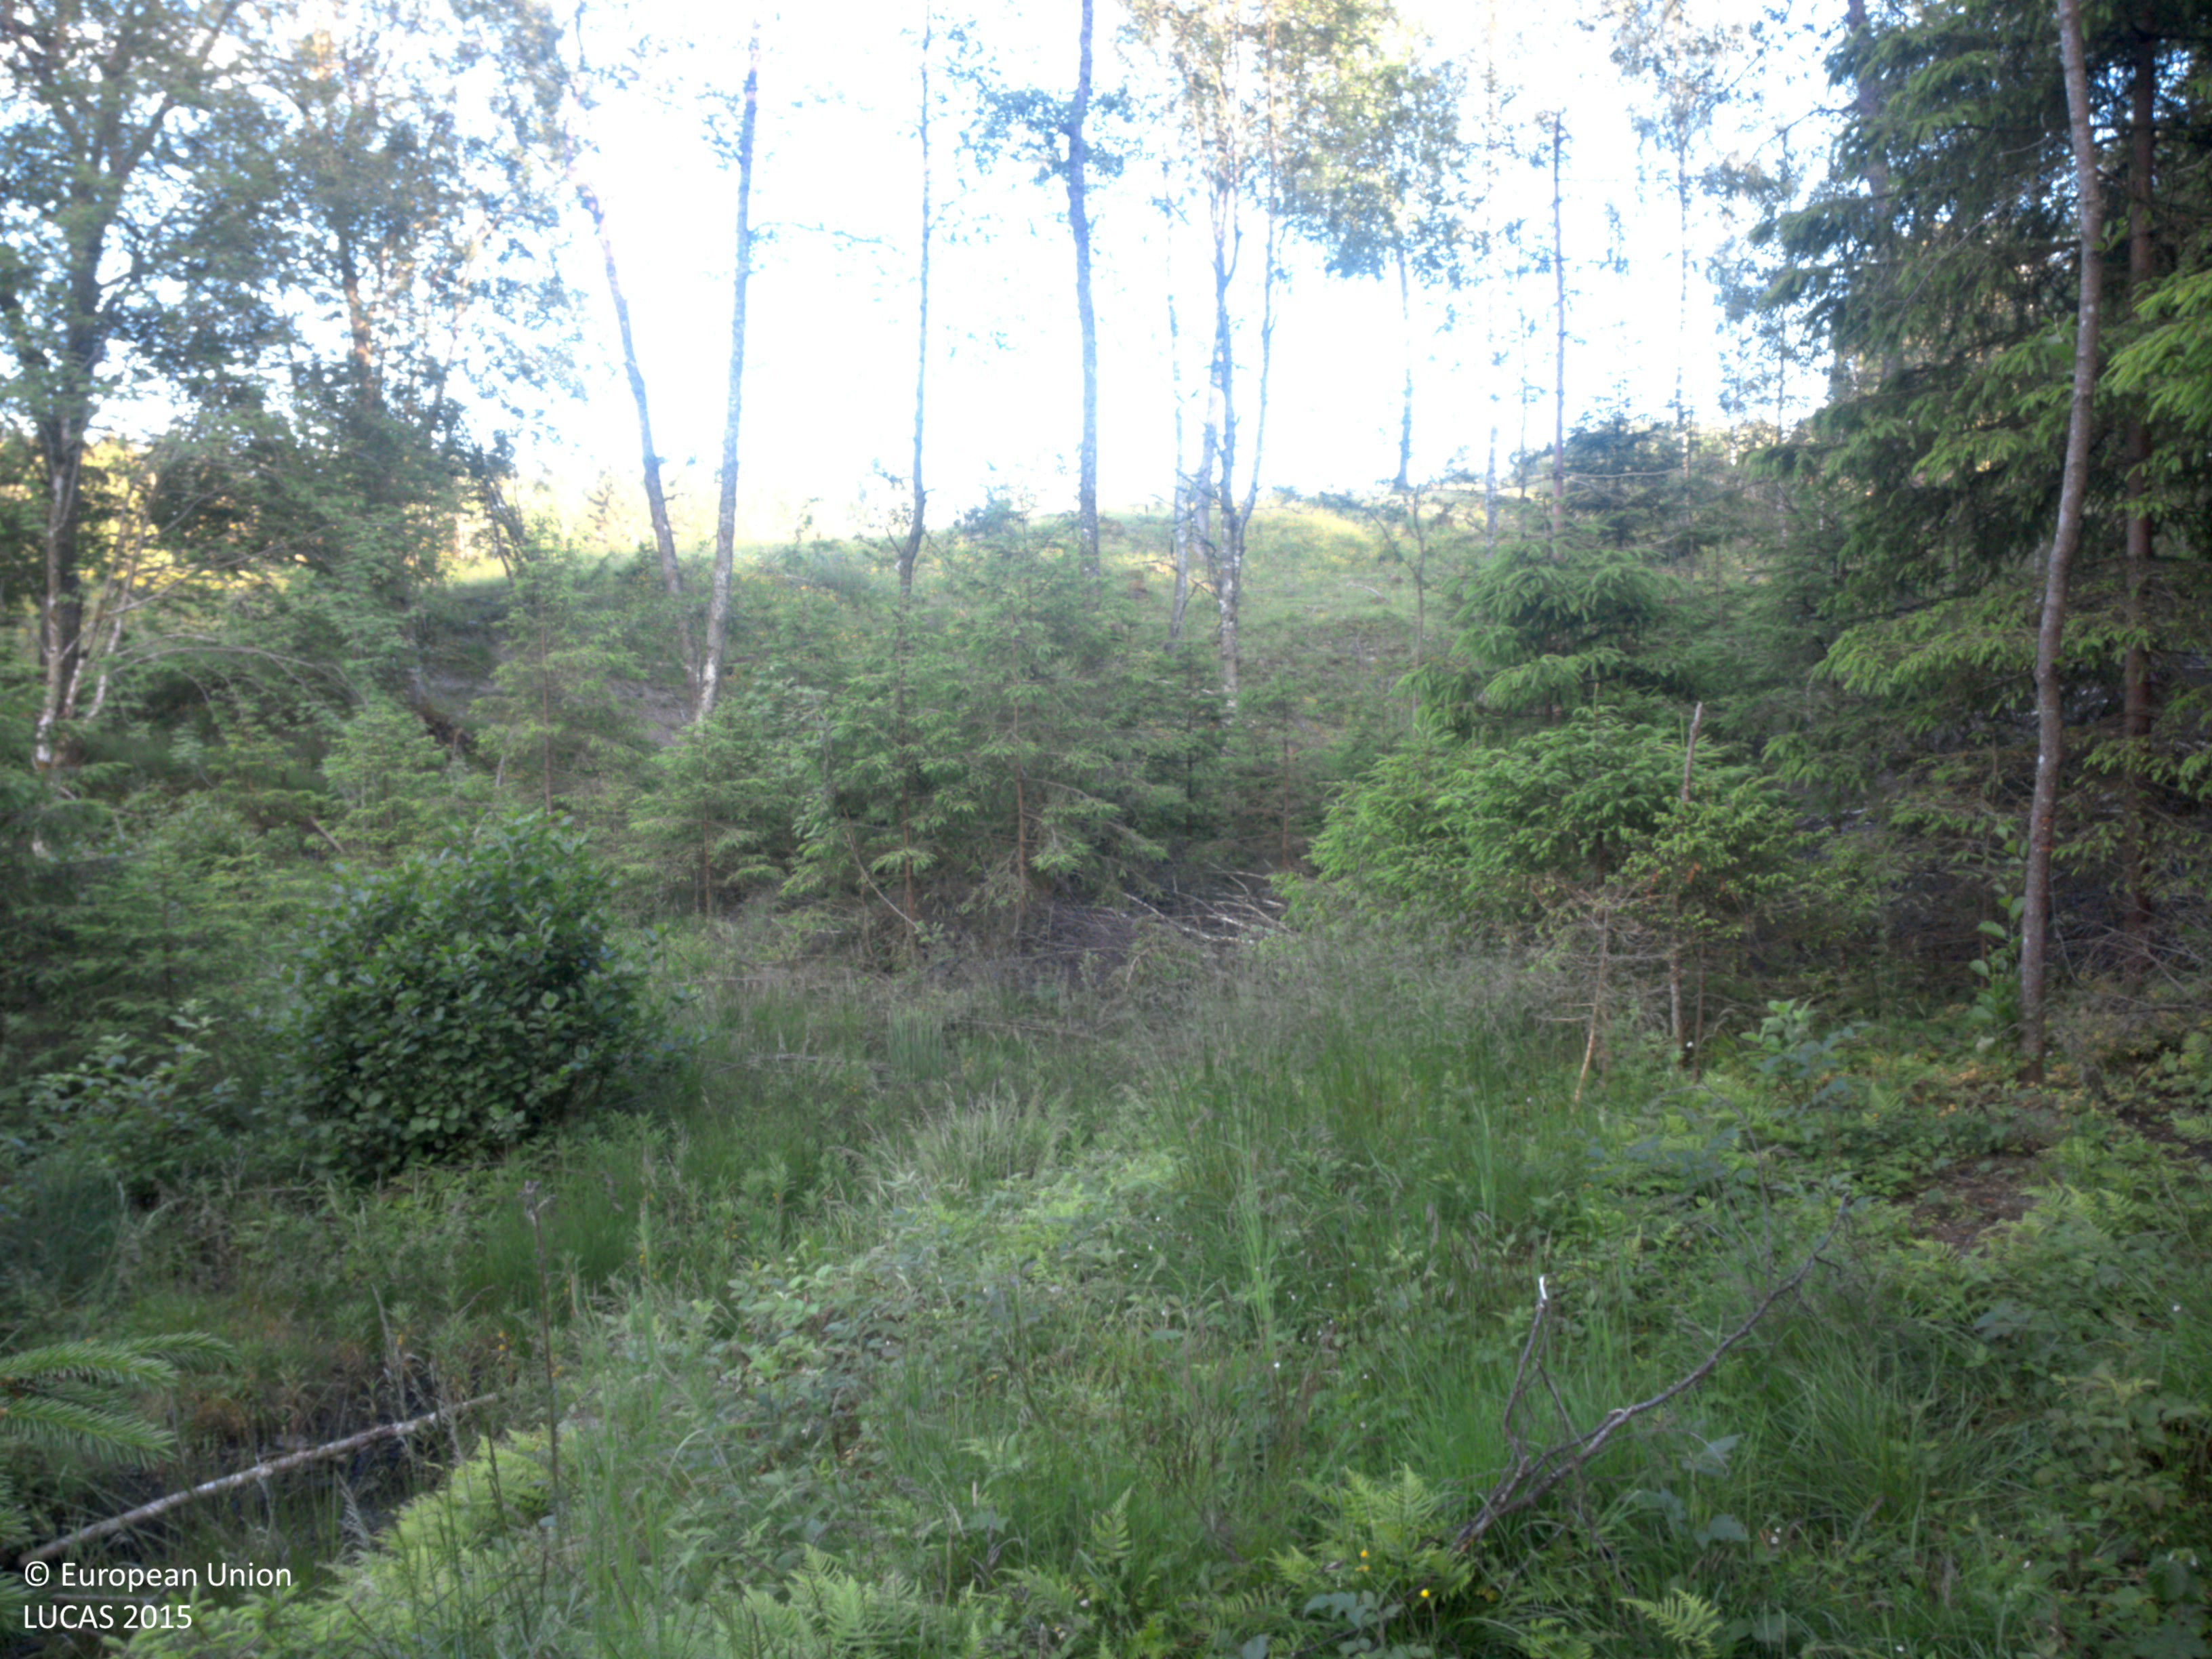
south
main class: Woodland
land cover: Spruce dominated mixed woodland
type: boreal forest
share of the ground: 25 - 50 %
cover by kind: herbaceous plants 40 %, coniferous forest trees 30 %, broadleaved forest trees 15 %, shrubs 15 %
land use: Forestry
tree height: < 5 m
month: June
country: SE
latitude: 58.8224
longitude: 11.5378
